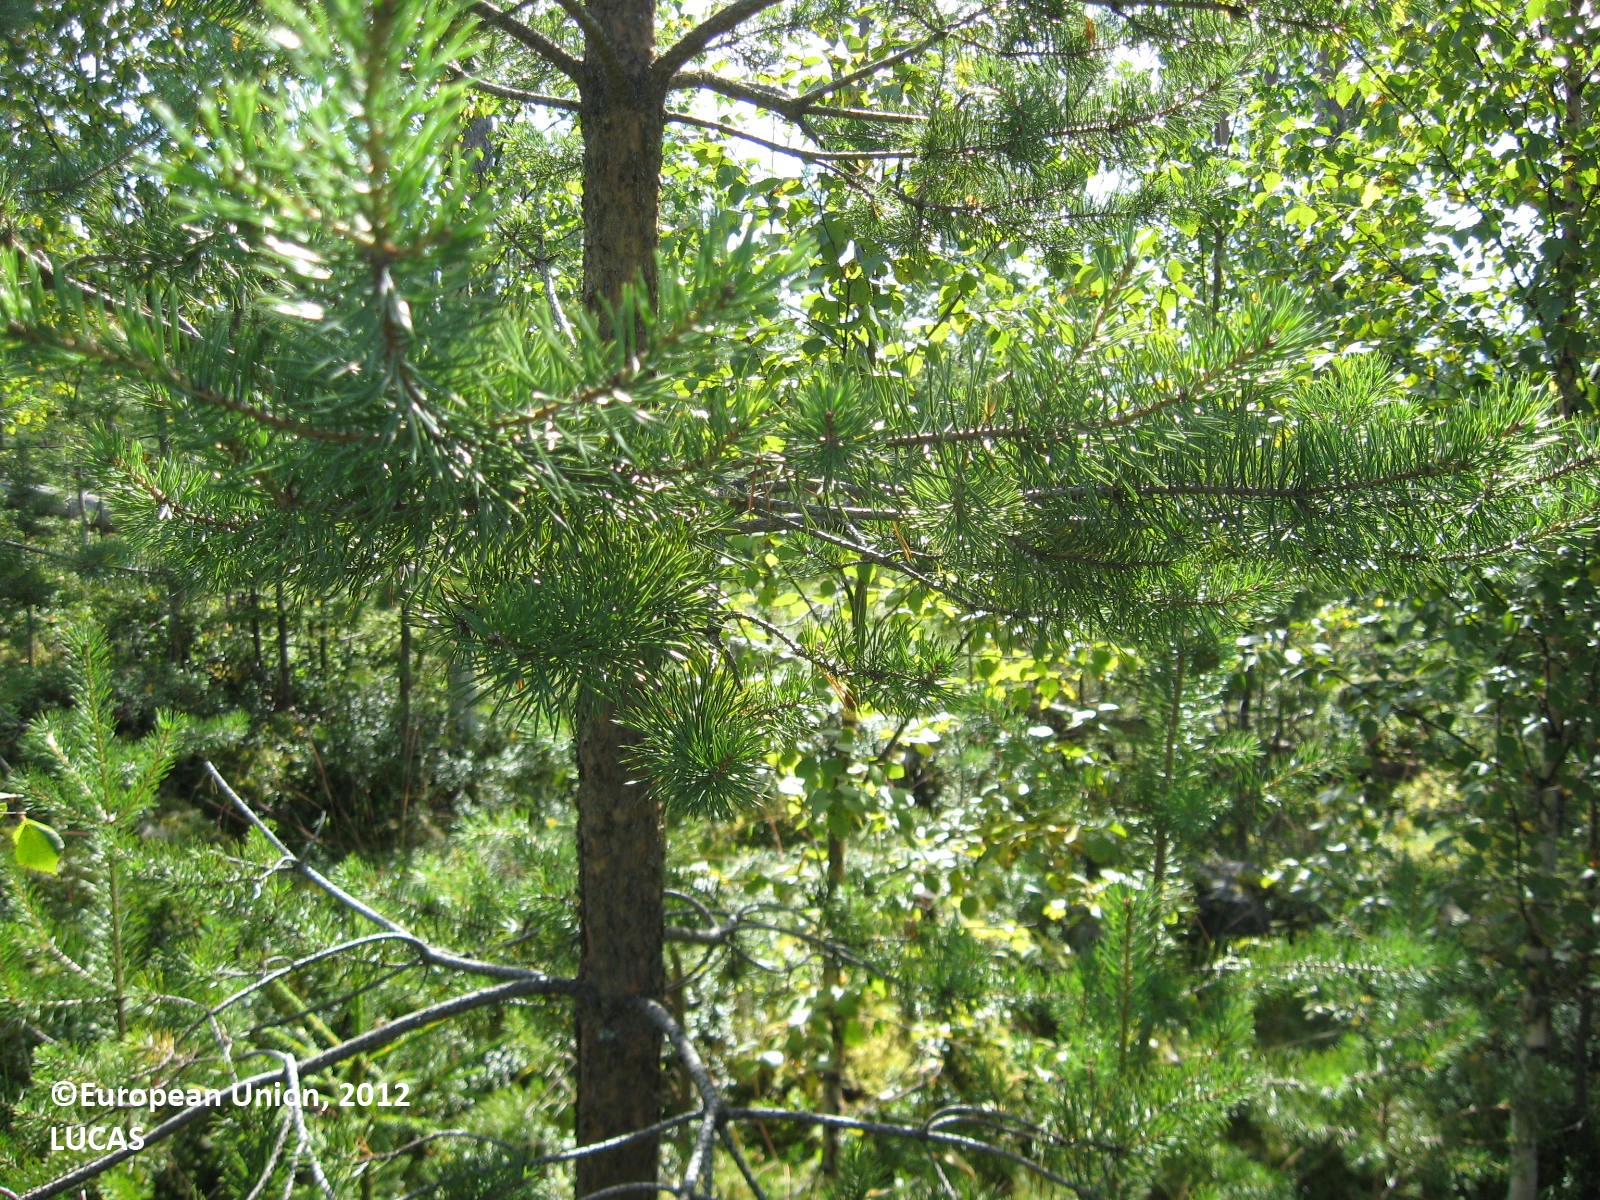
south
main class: Woodland
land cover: Pine dominated mixed woodland
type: boreal forest
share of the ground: > 75 %
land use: Forestry
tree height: > 5 m
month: August
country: FI
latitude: 63.8590
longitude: 28.7679
